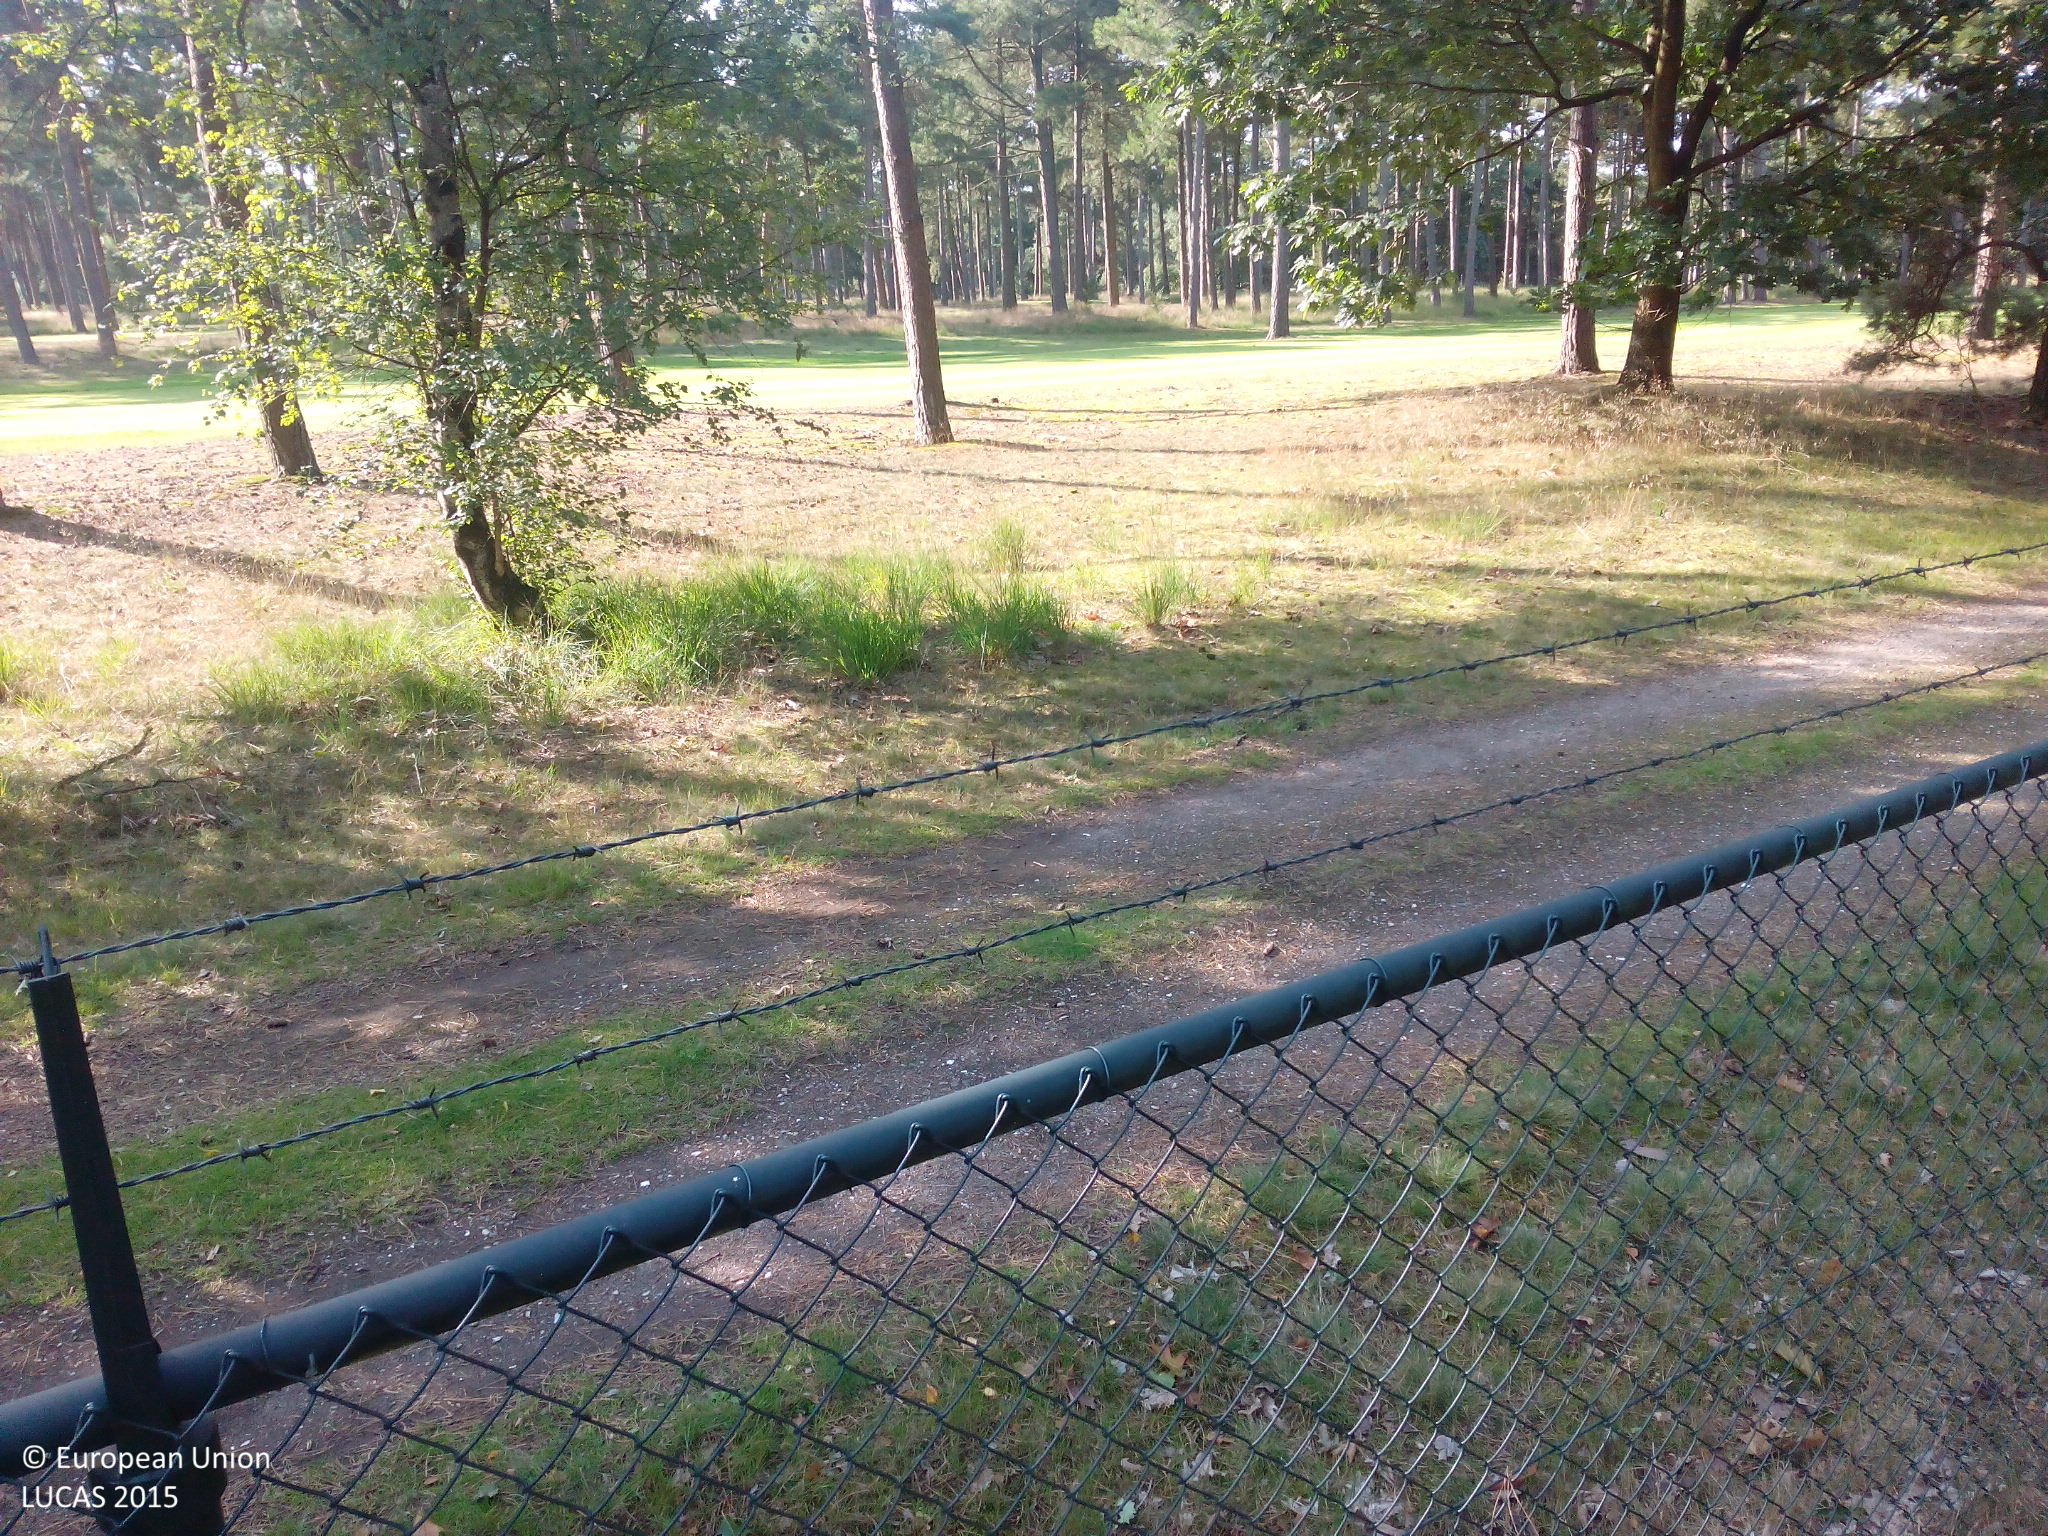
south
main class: Grassland
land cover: Grassland without tree/shrub cover
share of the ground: > 75 %
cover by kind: herbaceous plants 100 %
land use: Sport
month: August
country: NL
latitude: 51.3415
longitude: 5.5911
